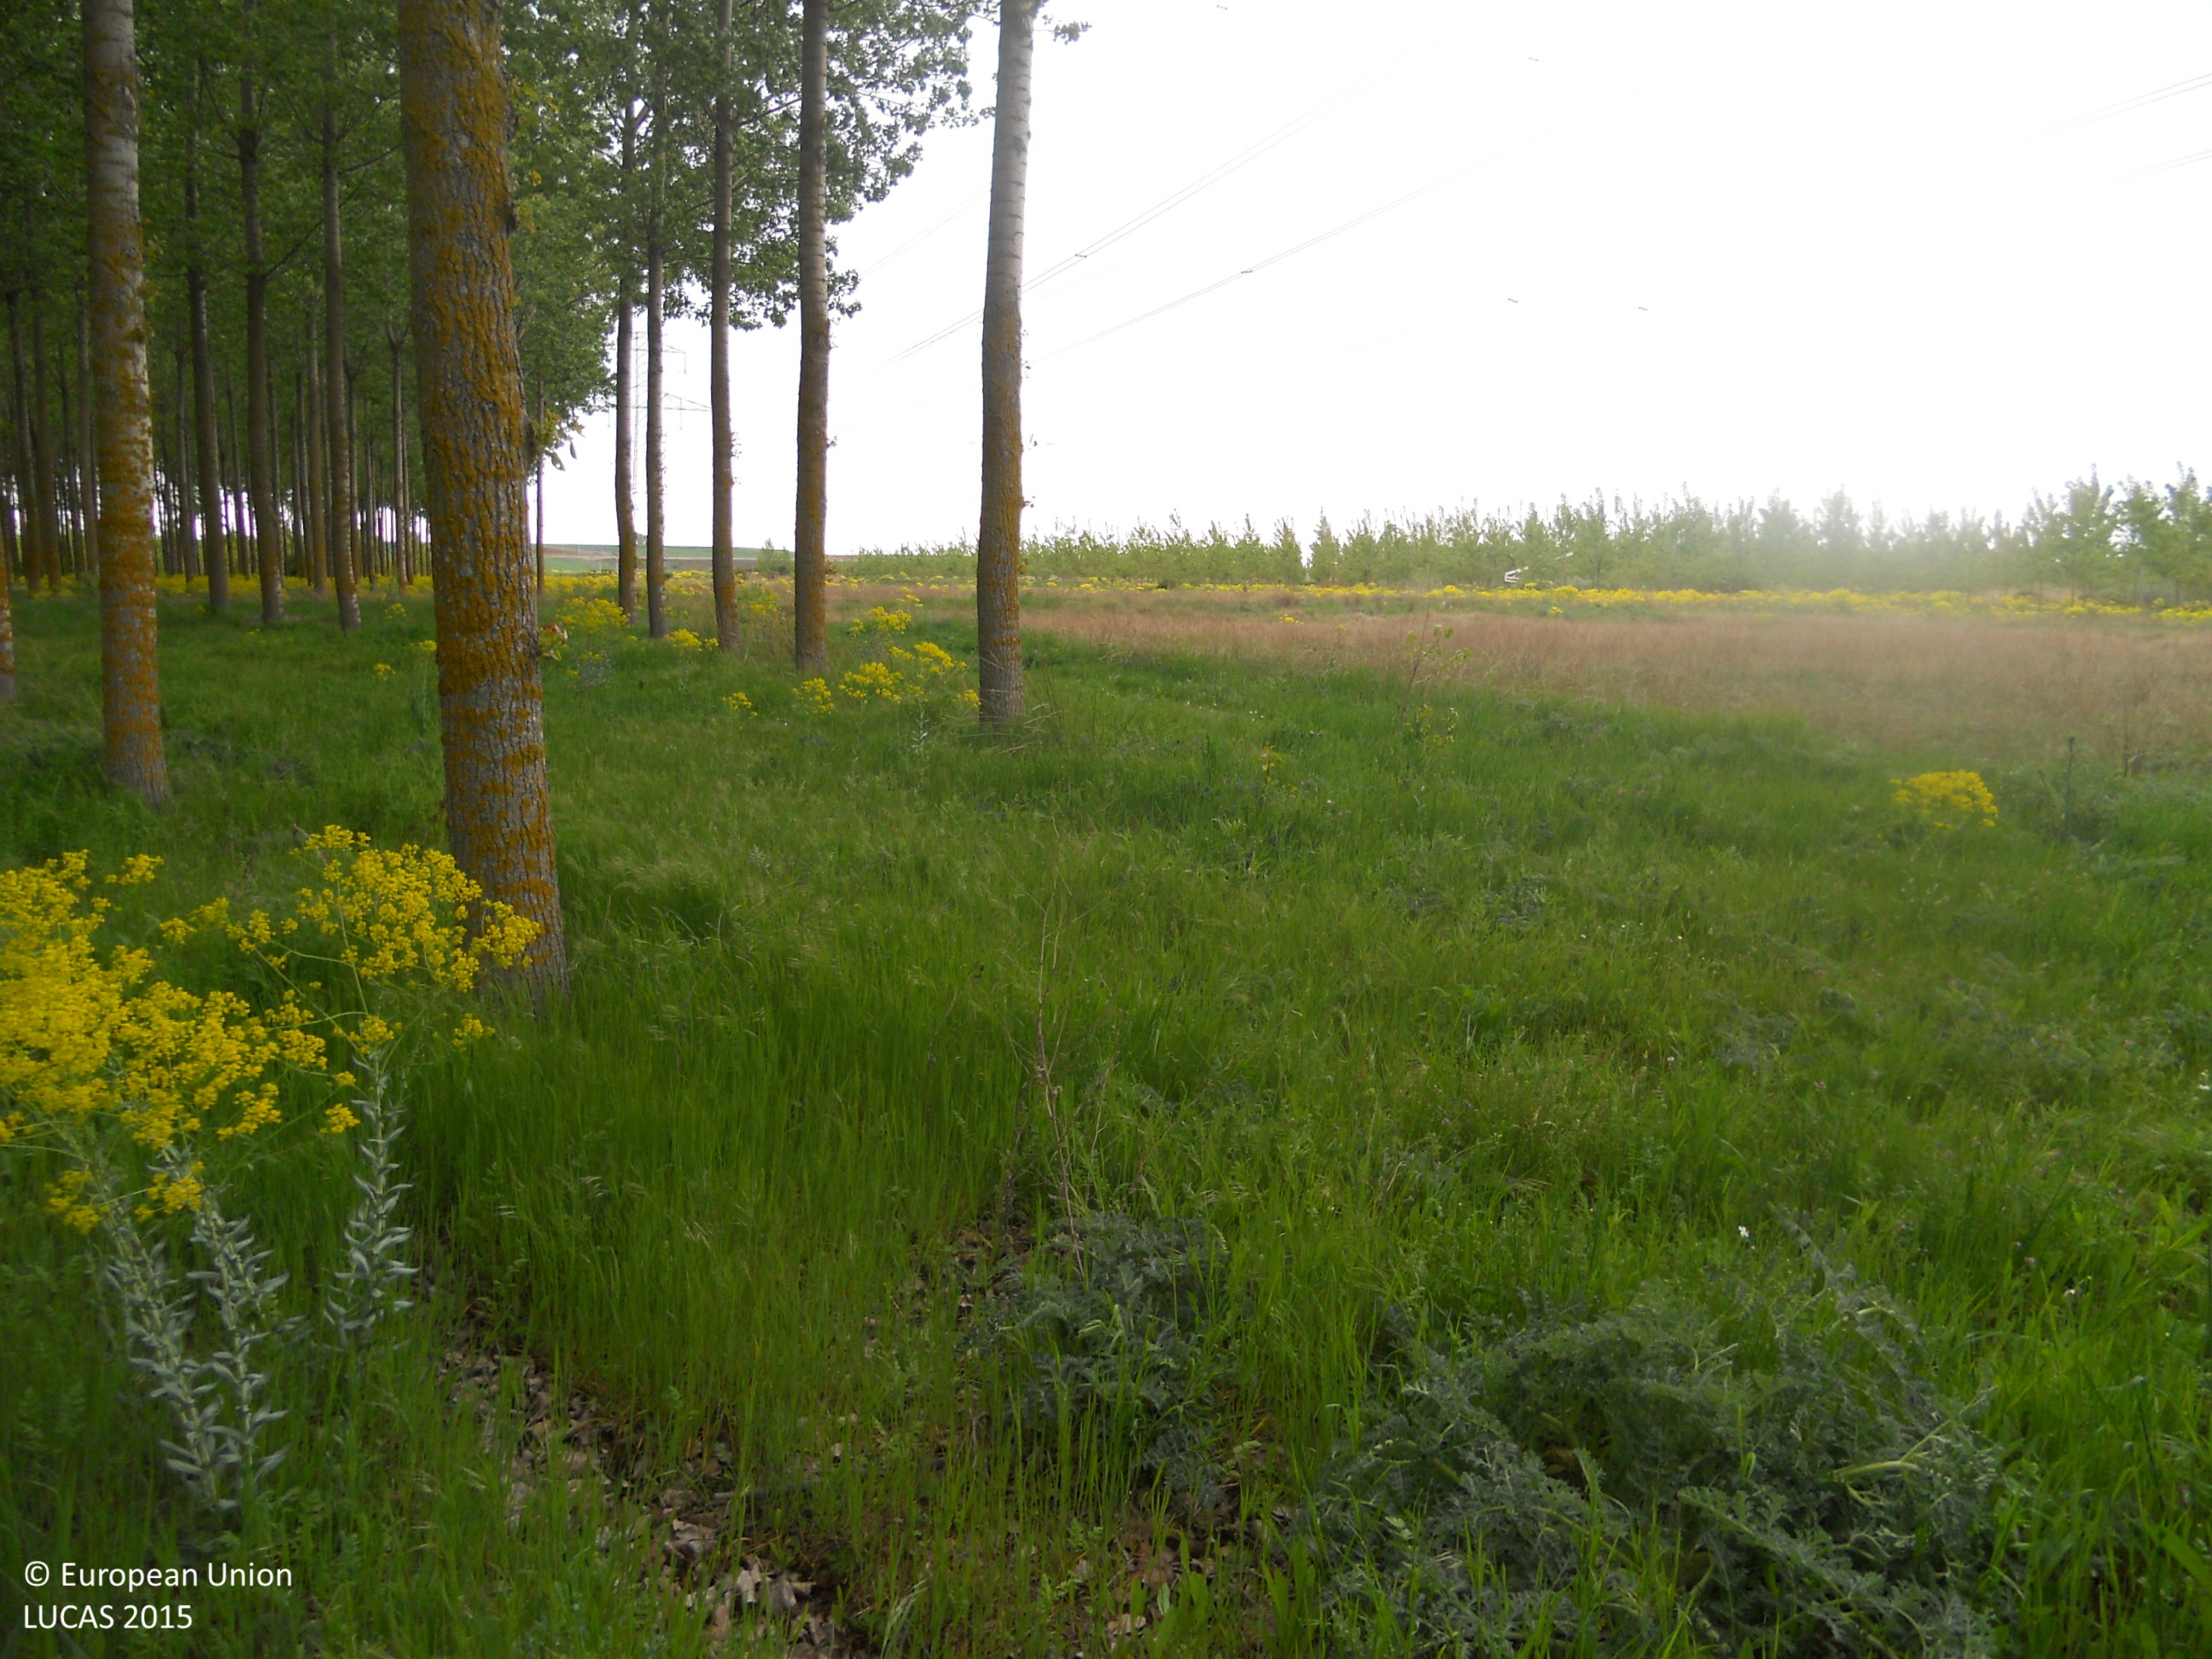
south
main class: Woodland
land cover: Broadleaved woodland
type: floodplain forest
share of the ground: > 75 %
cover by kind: broadleaved forest trees 100 %
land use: Forestry
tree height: > 5 m
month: May
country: ES
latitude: 42.4624
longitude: -5.3782
